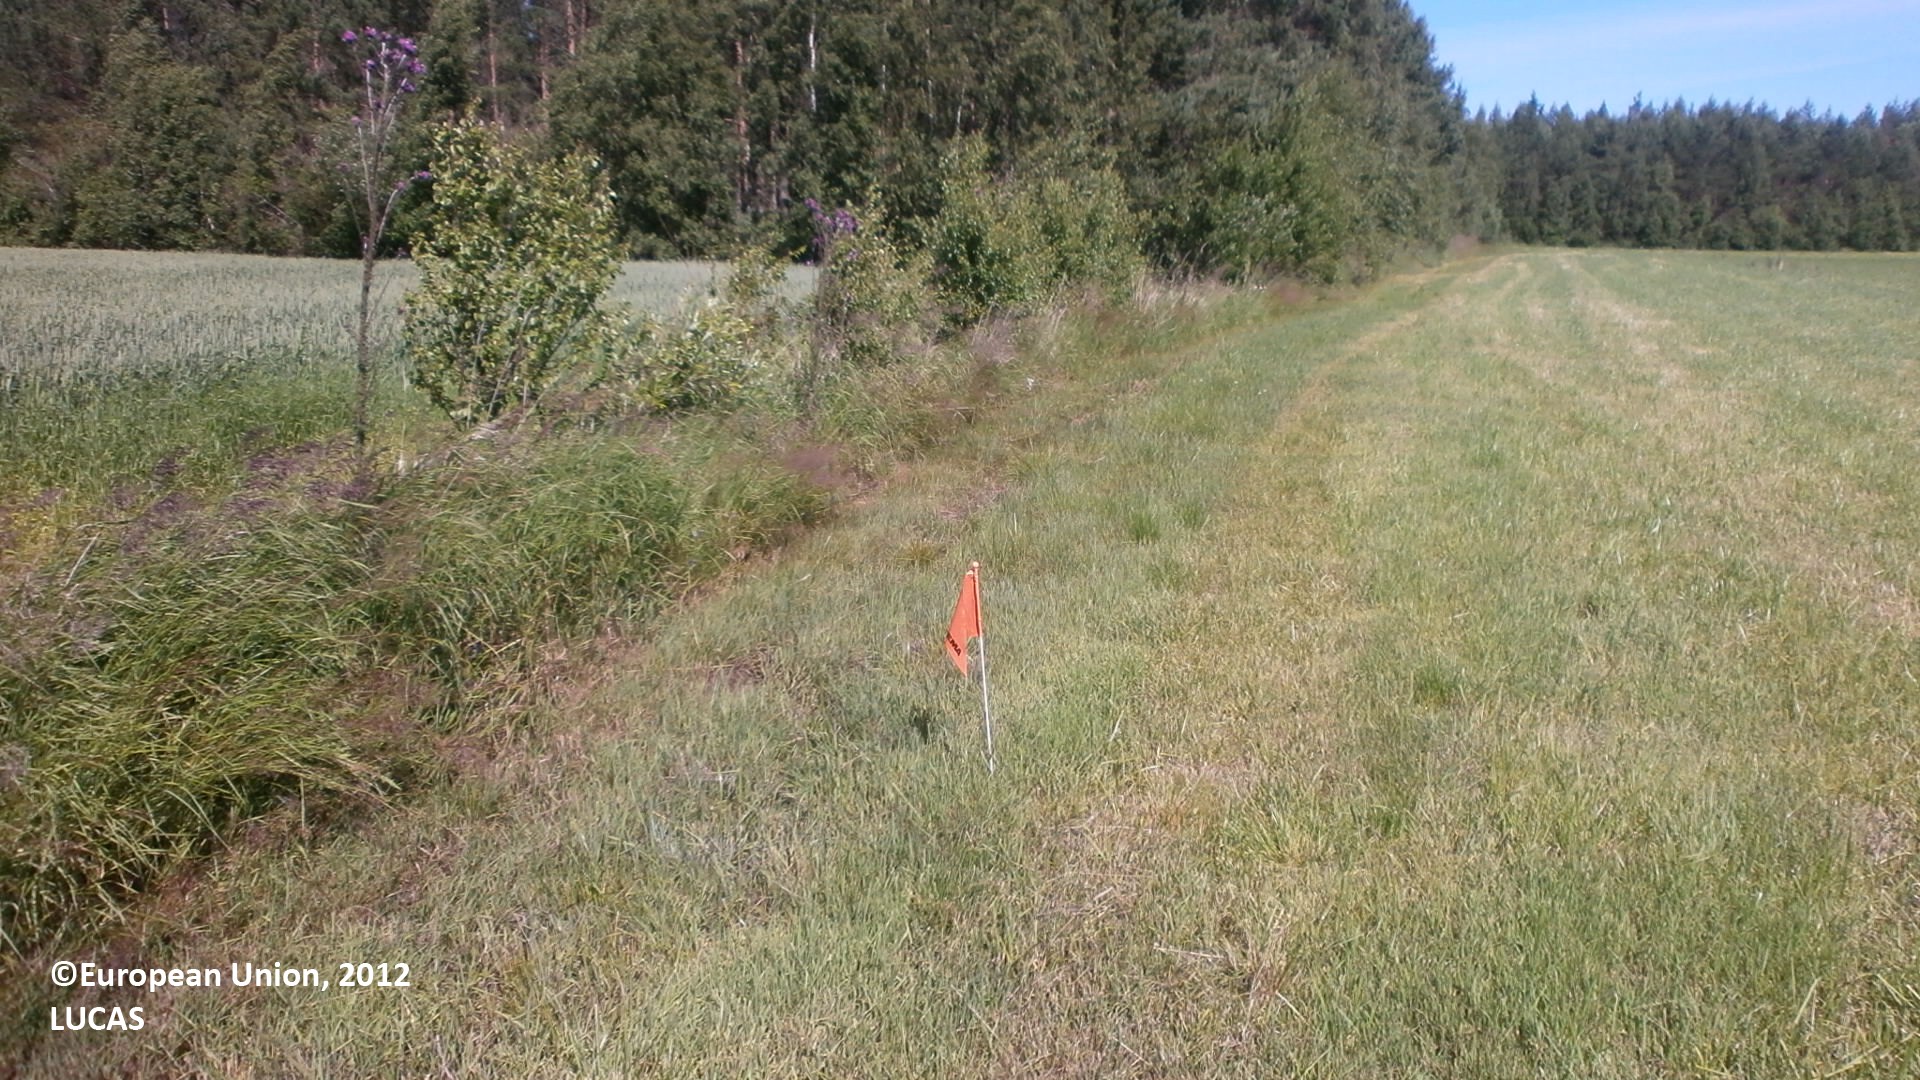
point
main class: Cropland
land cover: Temporary grasslands
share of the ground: > 75 %
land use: Agriculture (excluding fallow land and kitchen gardens)
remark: Harvested field
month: July
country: FI
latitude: 64.3763
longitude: 24.0516
